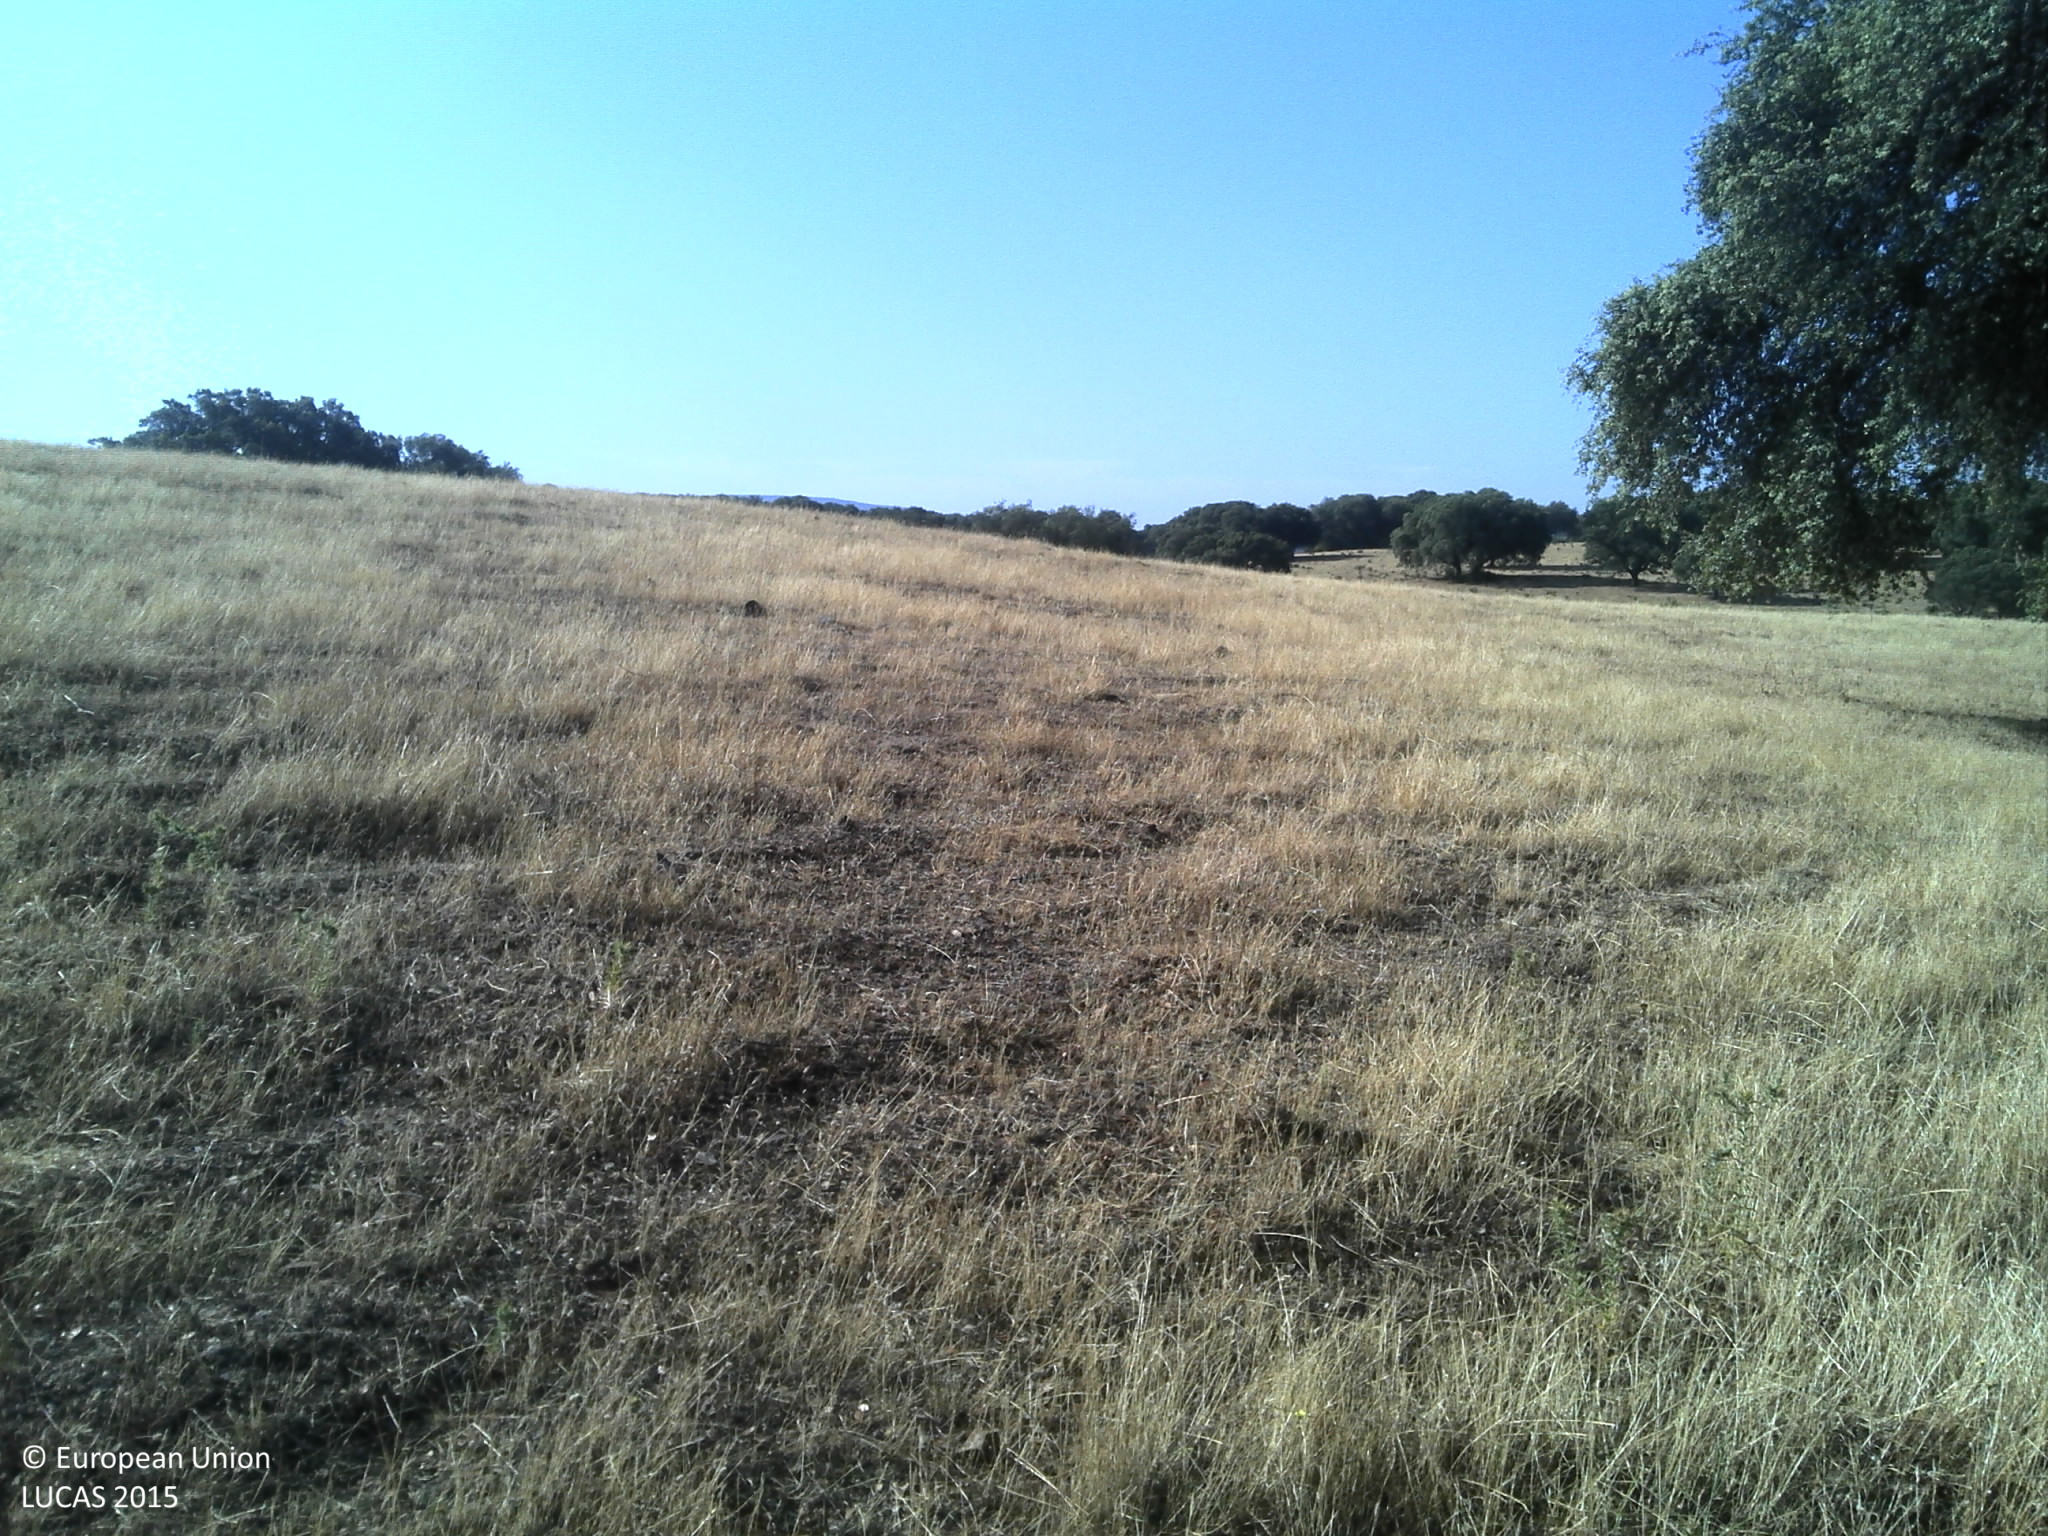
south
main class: Grassland
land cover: Grassland with sparse tree/shrub cover
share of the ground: 25 - 50 %
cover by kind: herbaceous plants 60 %, unconsolidated bare surface 30 %, broadleaved forest trees 5 %
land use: Agriculture (excluding fallow land and kitchen gardens)
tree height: > 5 m
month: June
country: PT
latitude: 40.0132
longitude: -7.0681
